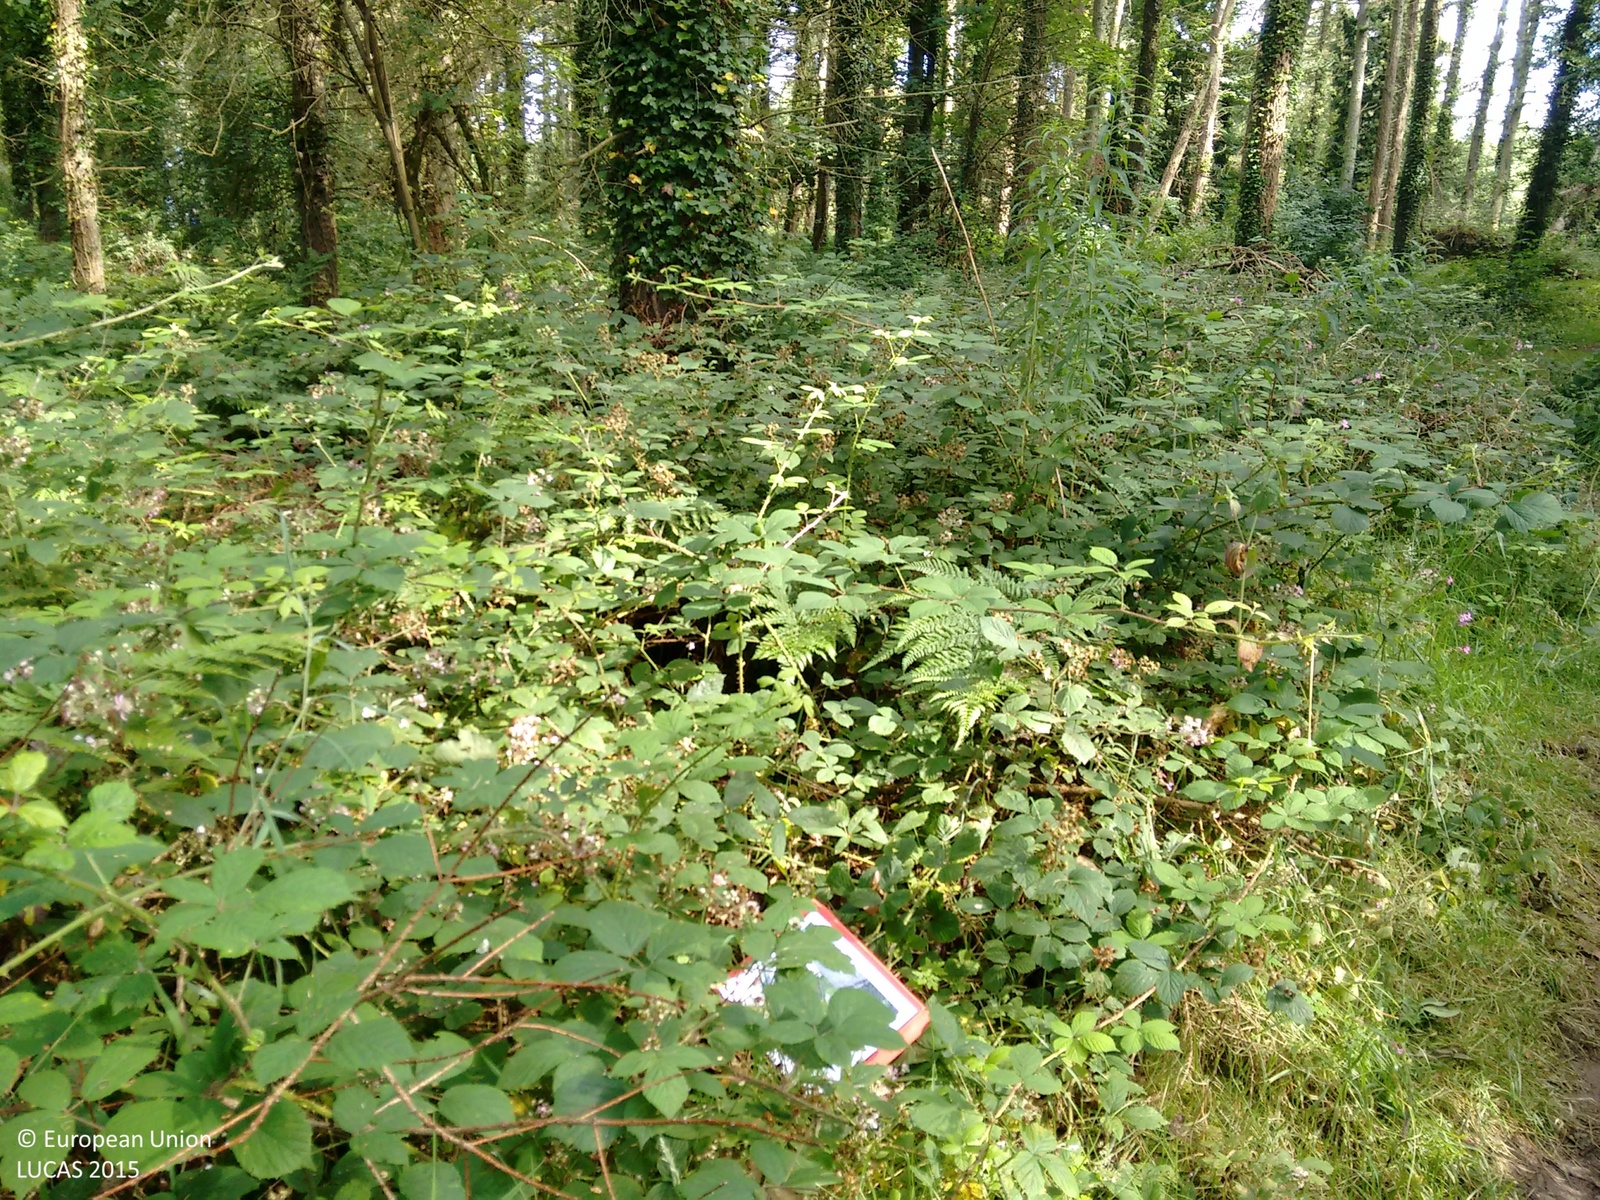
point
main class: Woodland
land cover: Pine dominated coniferous woodland
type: exotic forest
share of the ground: > 75 %
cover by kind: coniferous forest trees 100 %
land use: Forestry
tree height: > 5 m
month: August
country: GB
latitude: 53.2744
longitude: -4.3323
